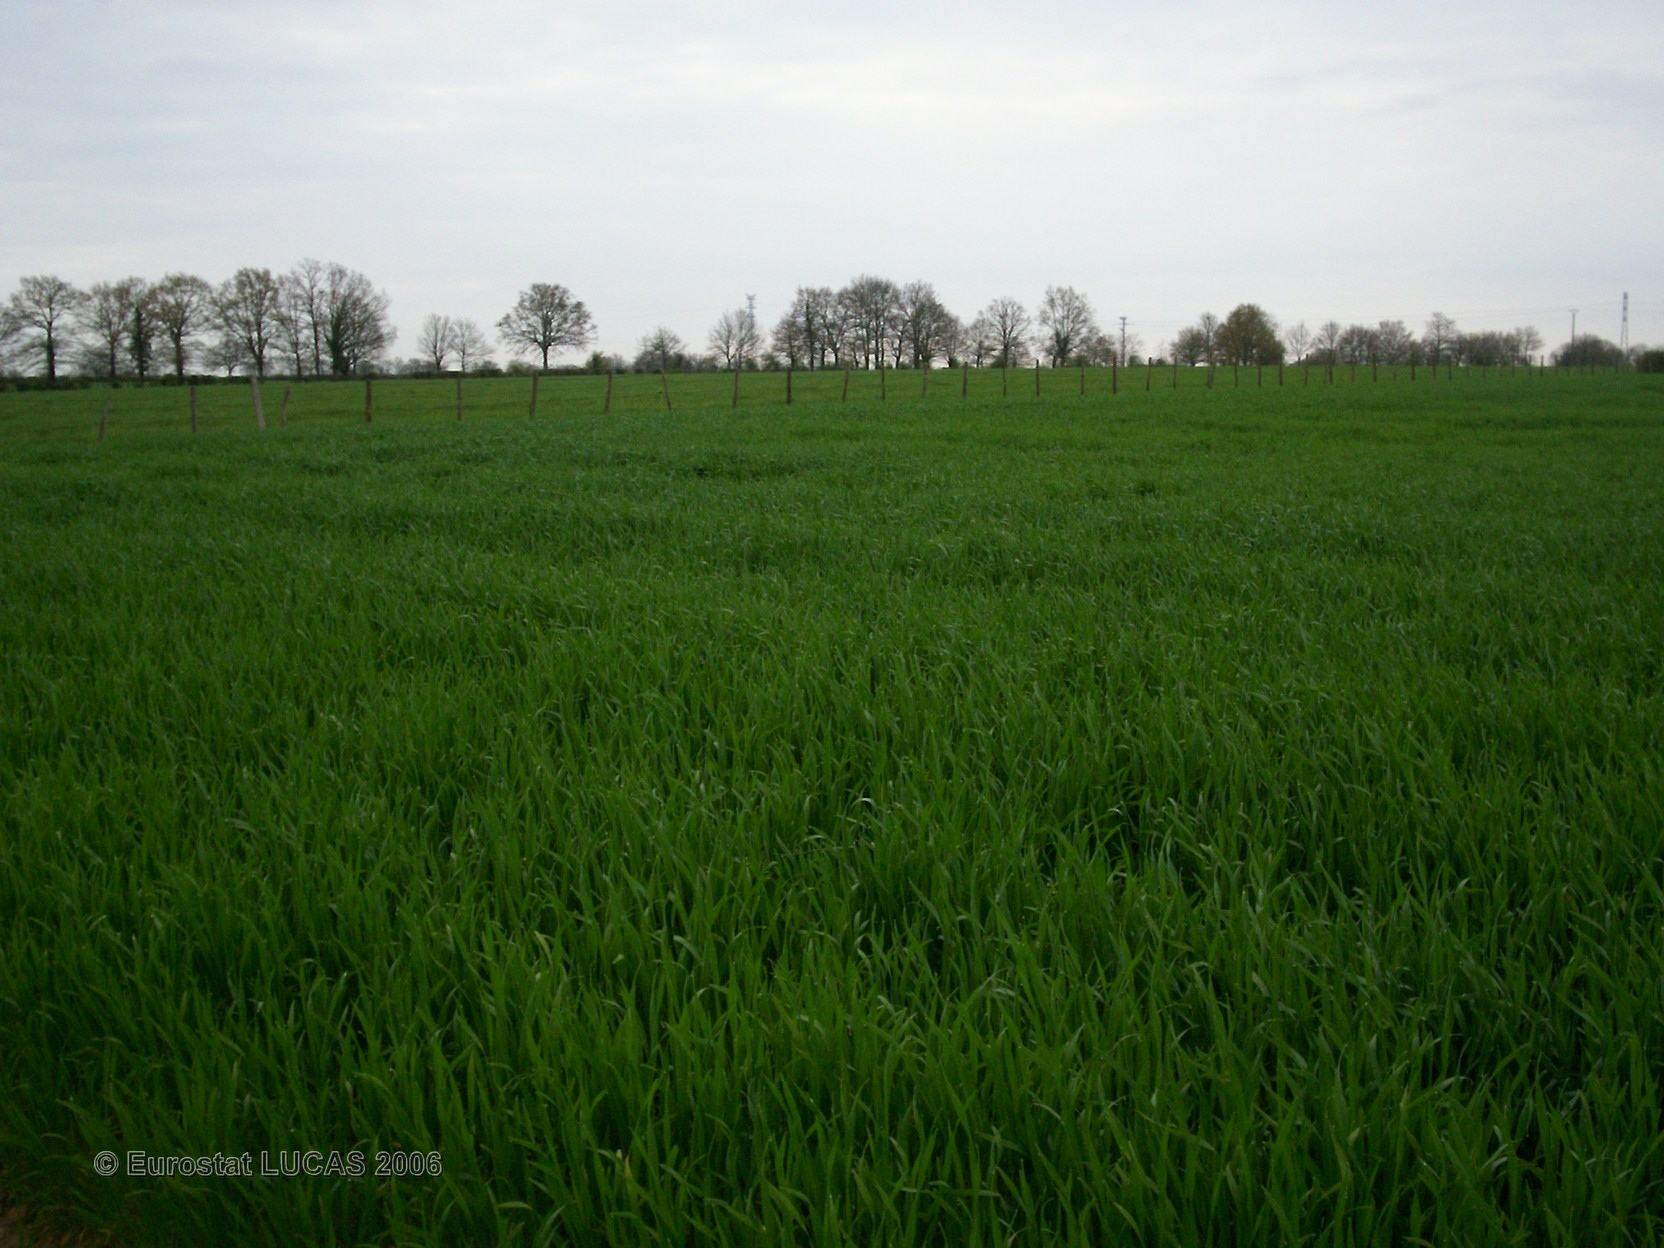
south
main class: Grassland
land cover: Grassland without tree/shrub cover
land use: Agriculture (excluding fallow land and kitchen gardens)
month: April
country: FR
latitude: 46.8438
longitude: -0.3730
